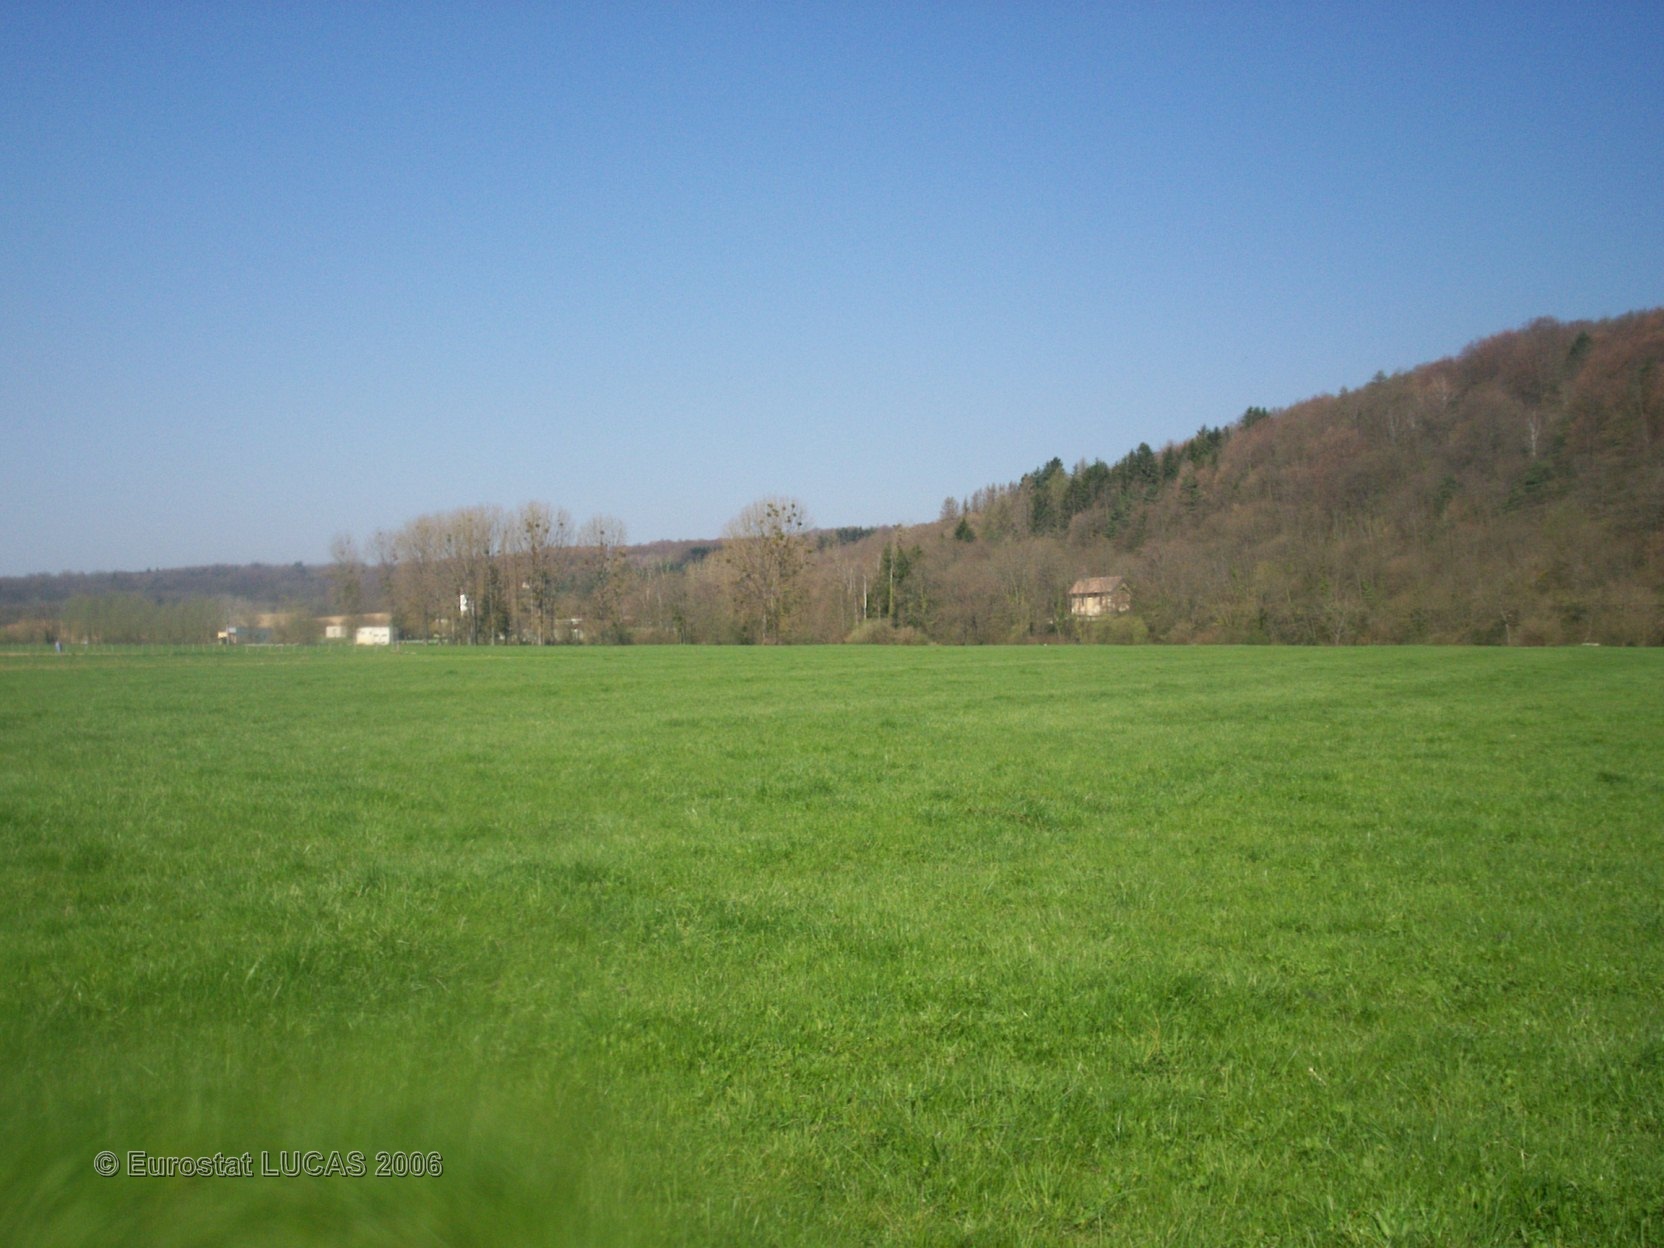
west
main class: Grassland
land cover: Grassland without tree/shrub cover
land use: Agriculture (excluding fallow land and kitchen gardens)
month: April
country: FR
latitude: 47.4568
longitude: 6.8050
